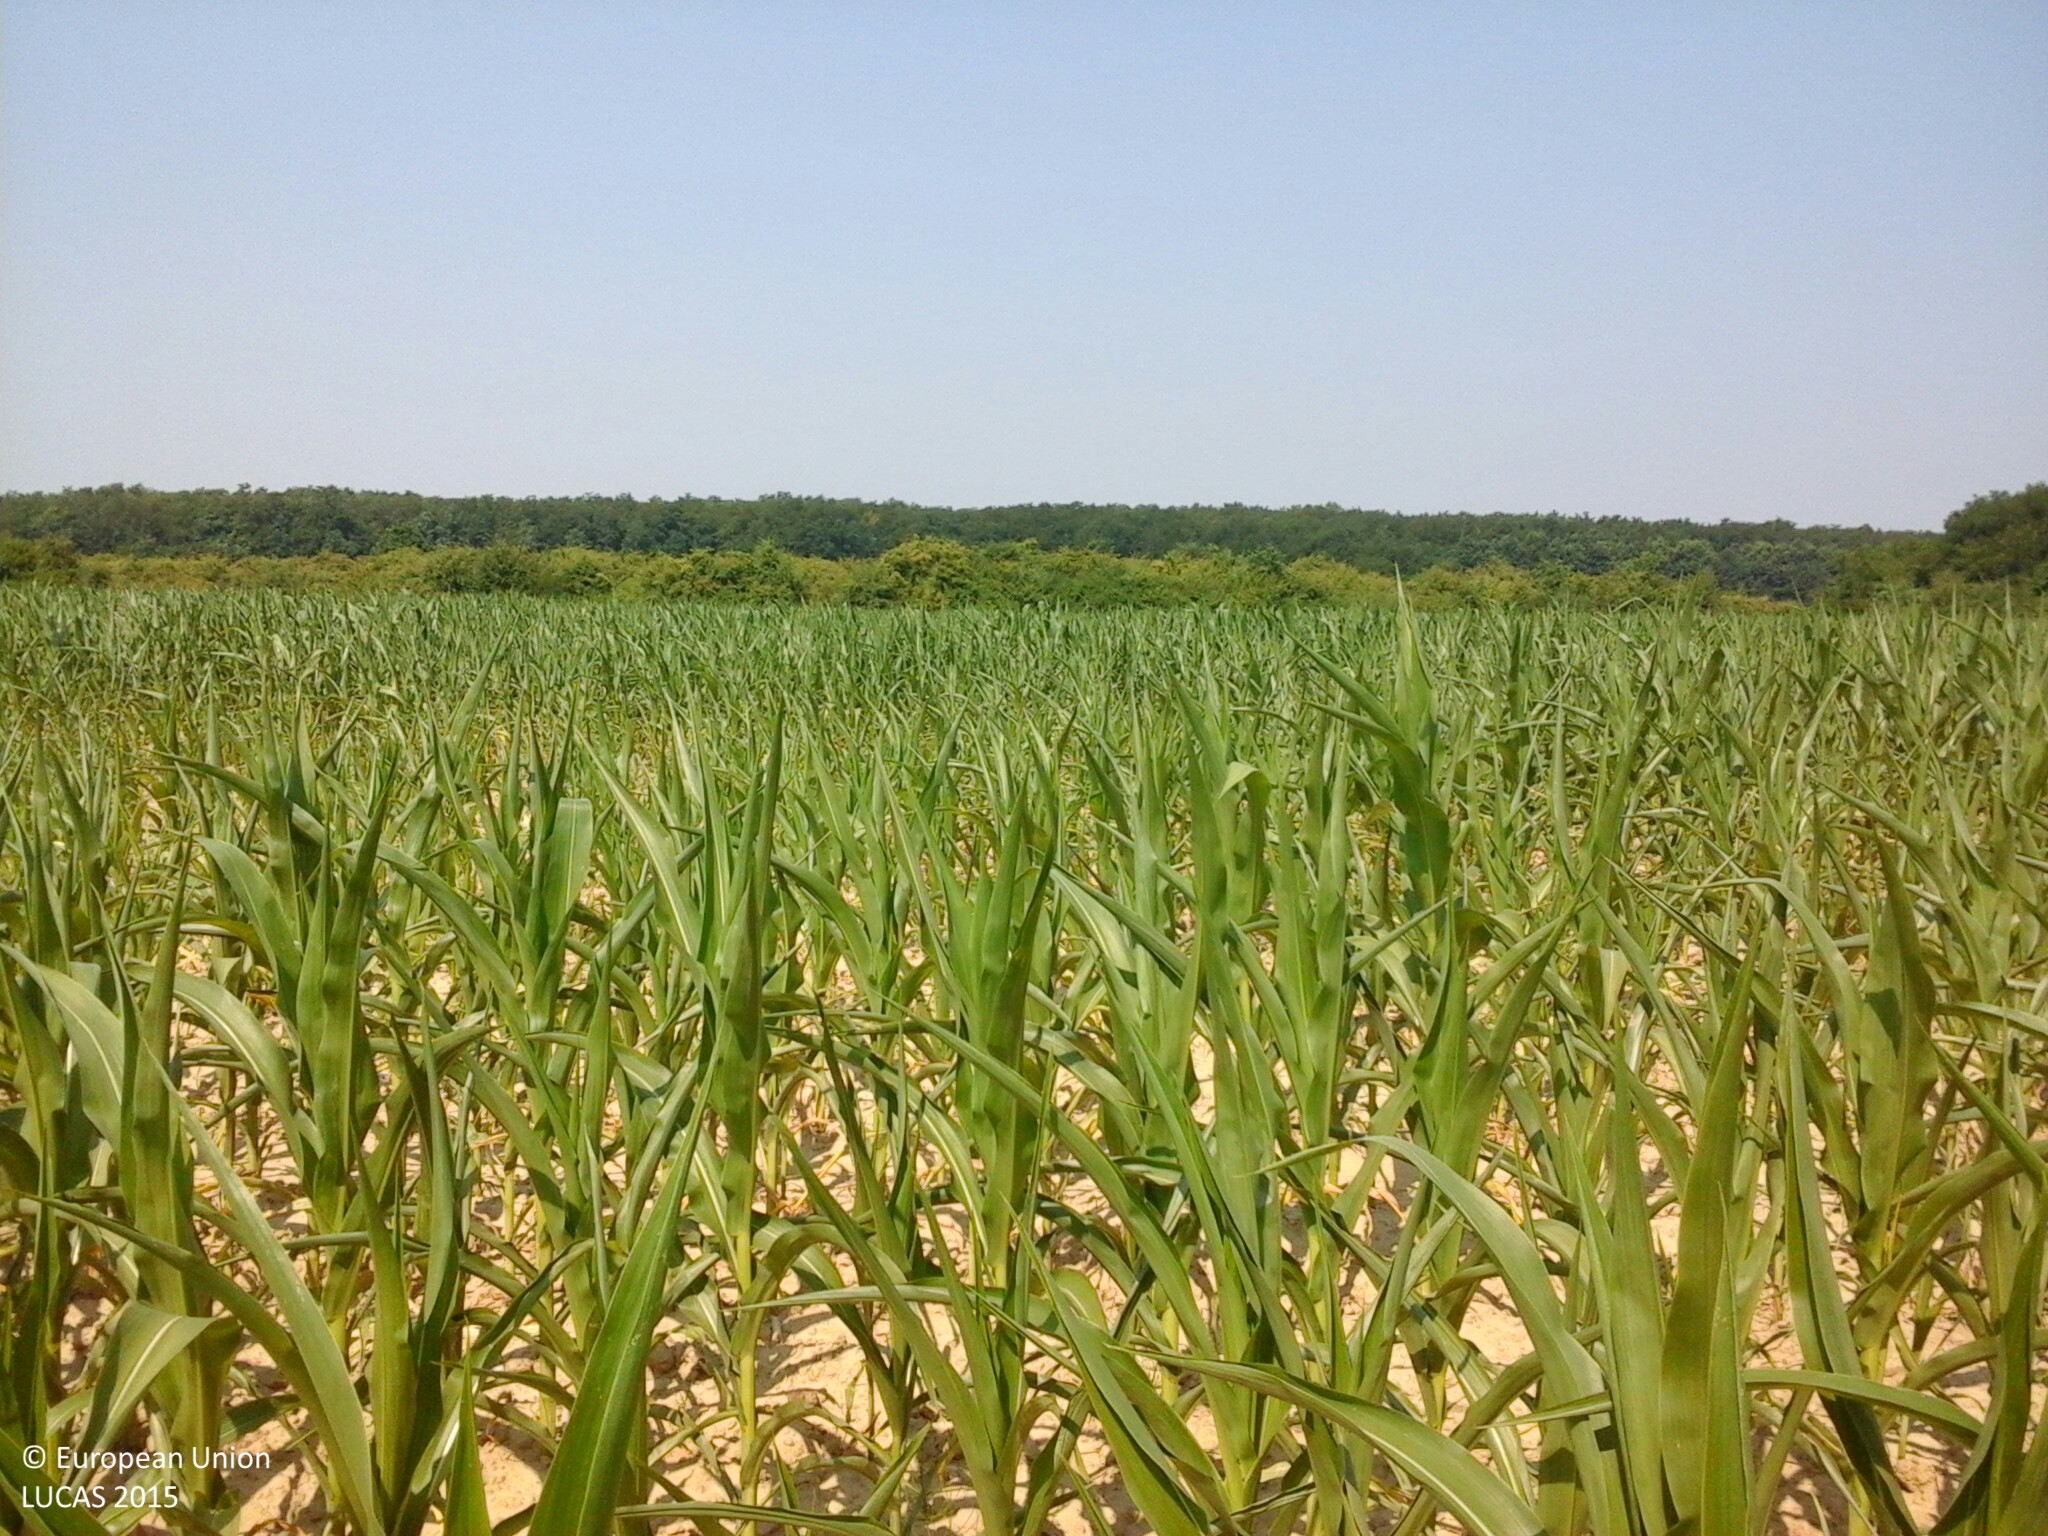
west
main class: Cropland
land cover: Maize
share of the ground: 50 - 75 %
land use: Agriculture (excluding fallow land and kitchen gardens)
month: July
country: HU
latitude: 48.2920
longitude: 22.1732
